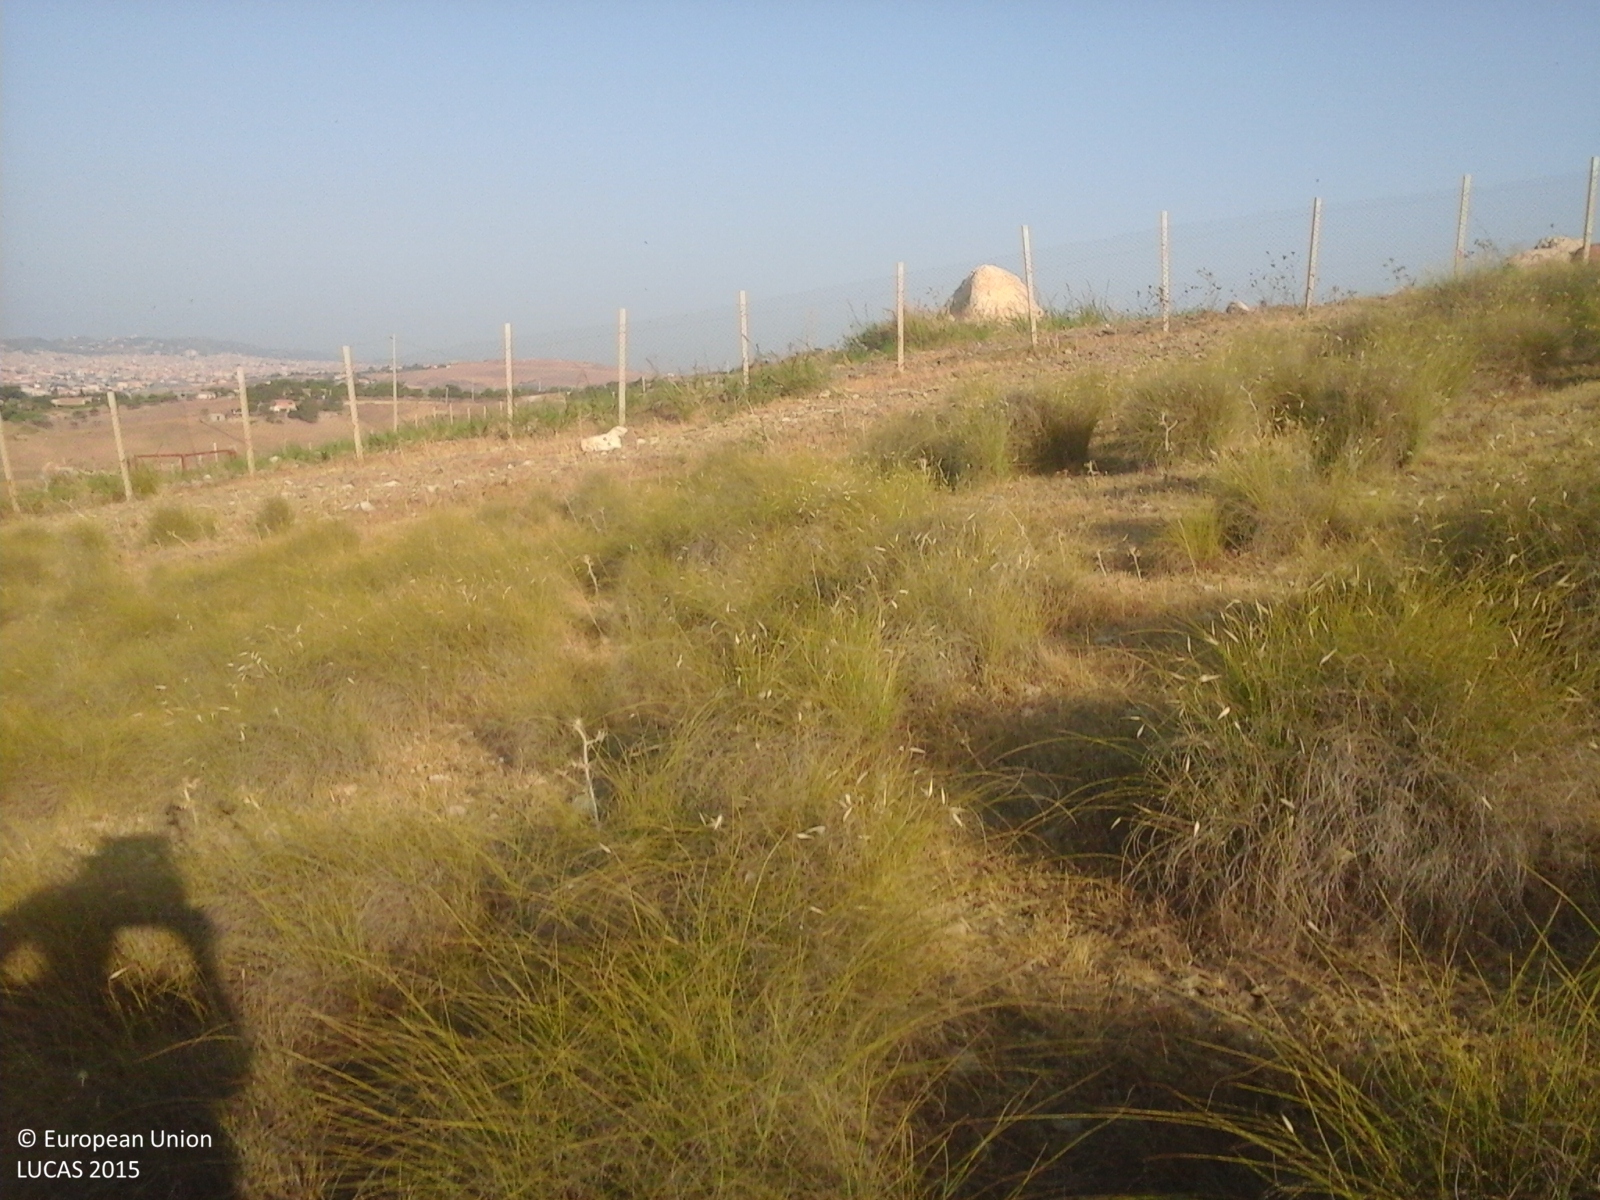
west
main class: Grassland
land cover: Grassland without tree/shrub cover
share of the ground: > 75 %
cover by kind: herbaceous plants 100 %
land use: Semi-natural and natural areas not in use
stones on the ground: < 10 %
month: July
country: IT
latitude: 37.1176
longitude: 14.0086
